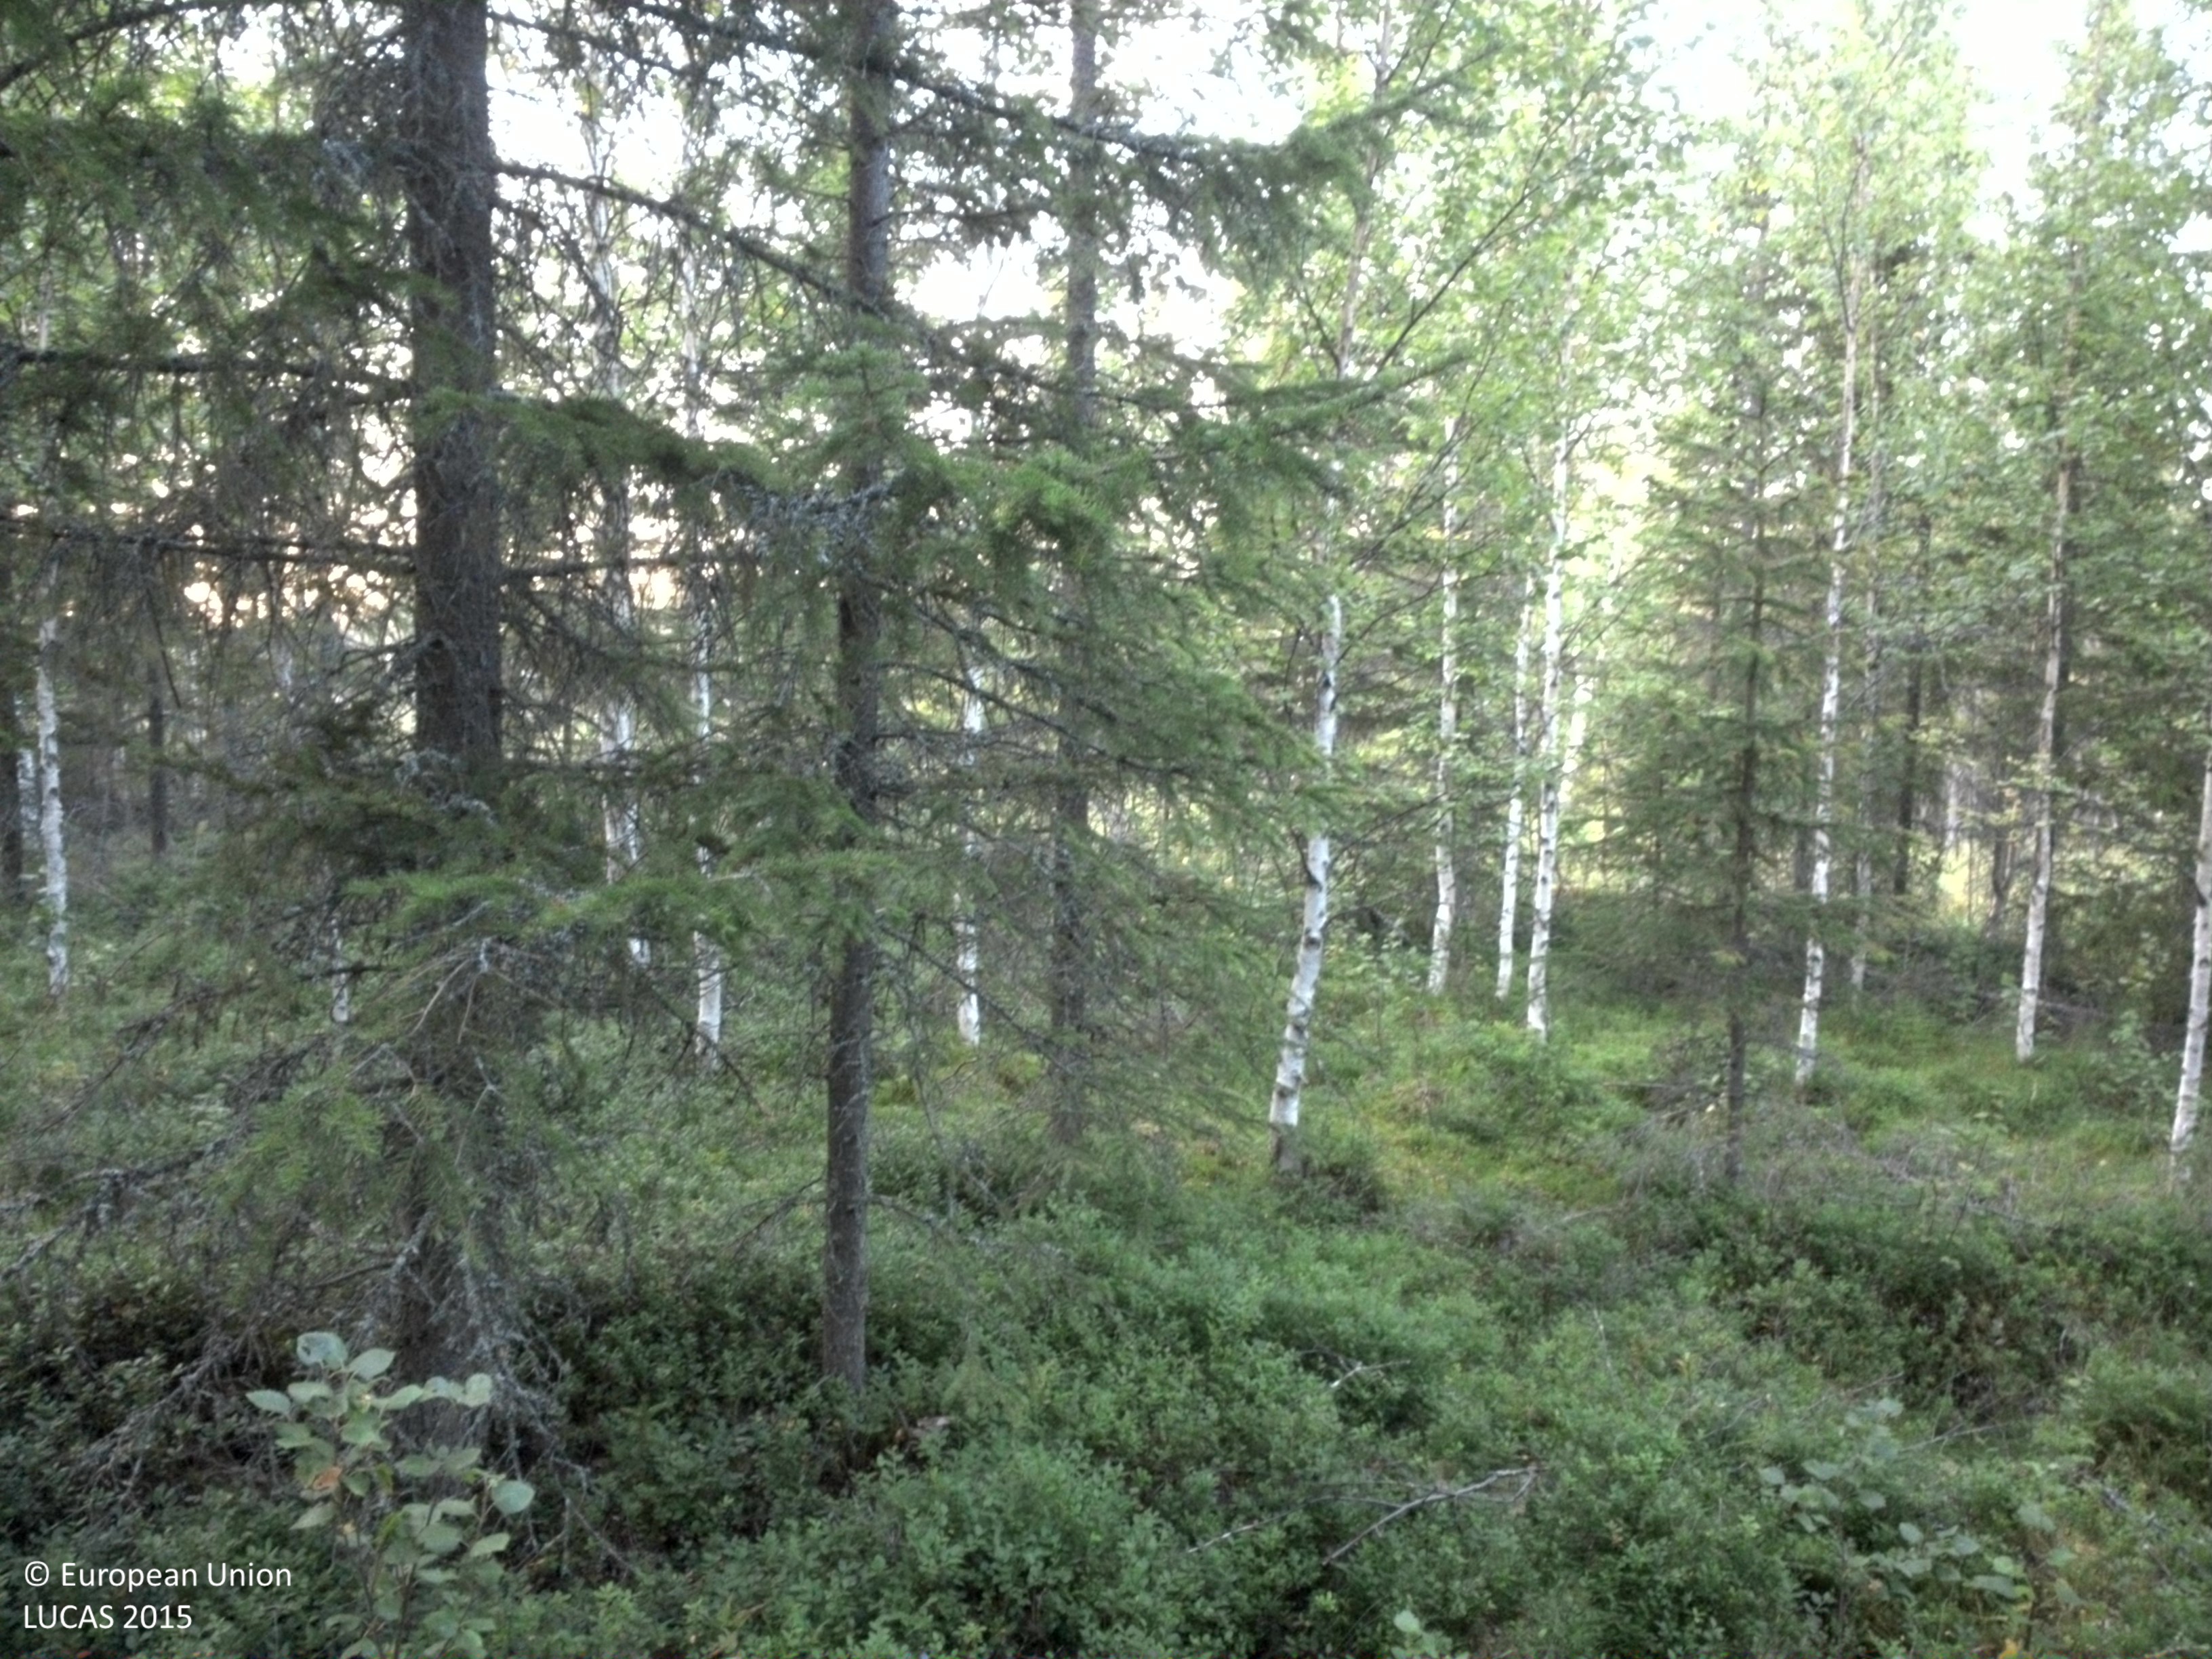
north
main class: Woodland
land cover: Spruce dominated mixed woodland
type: boreal forest
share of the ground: 50 - 75 %
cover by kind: coniferous forest trees 45 %, shrubs 30 %, broadleaved forest trees 15 %, lichens and mosses 10 %
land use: Forestry
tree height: > 5 m
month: August
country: SE
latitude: 64.3732
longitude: 18.7771
